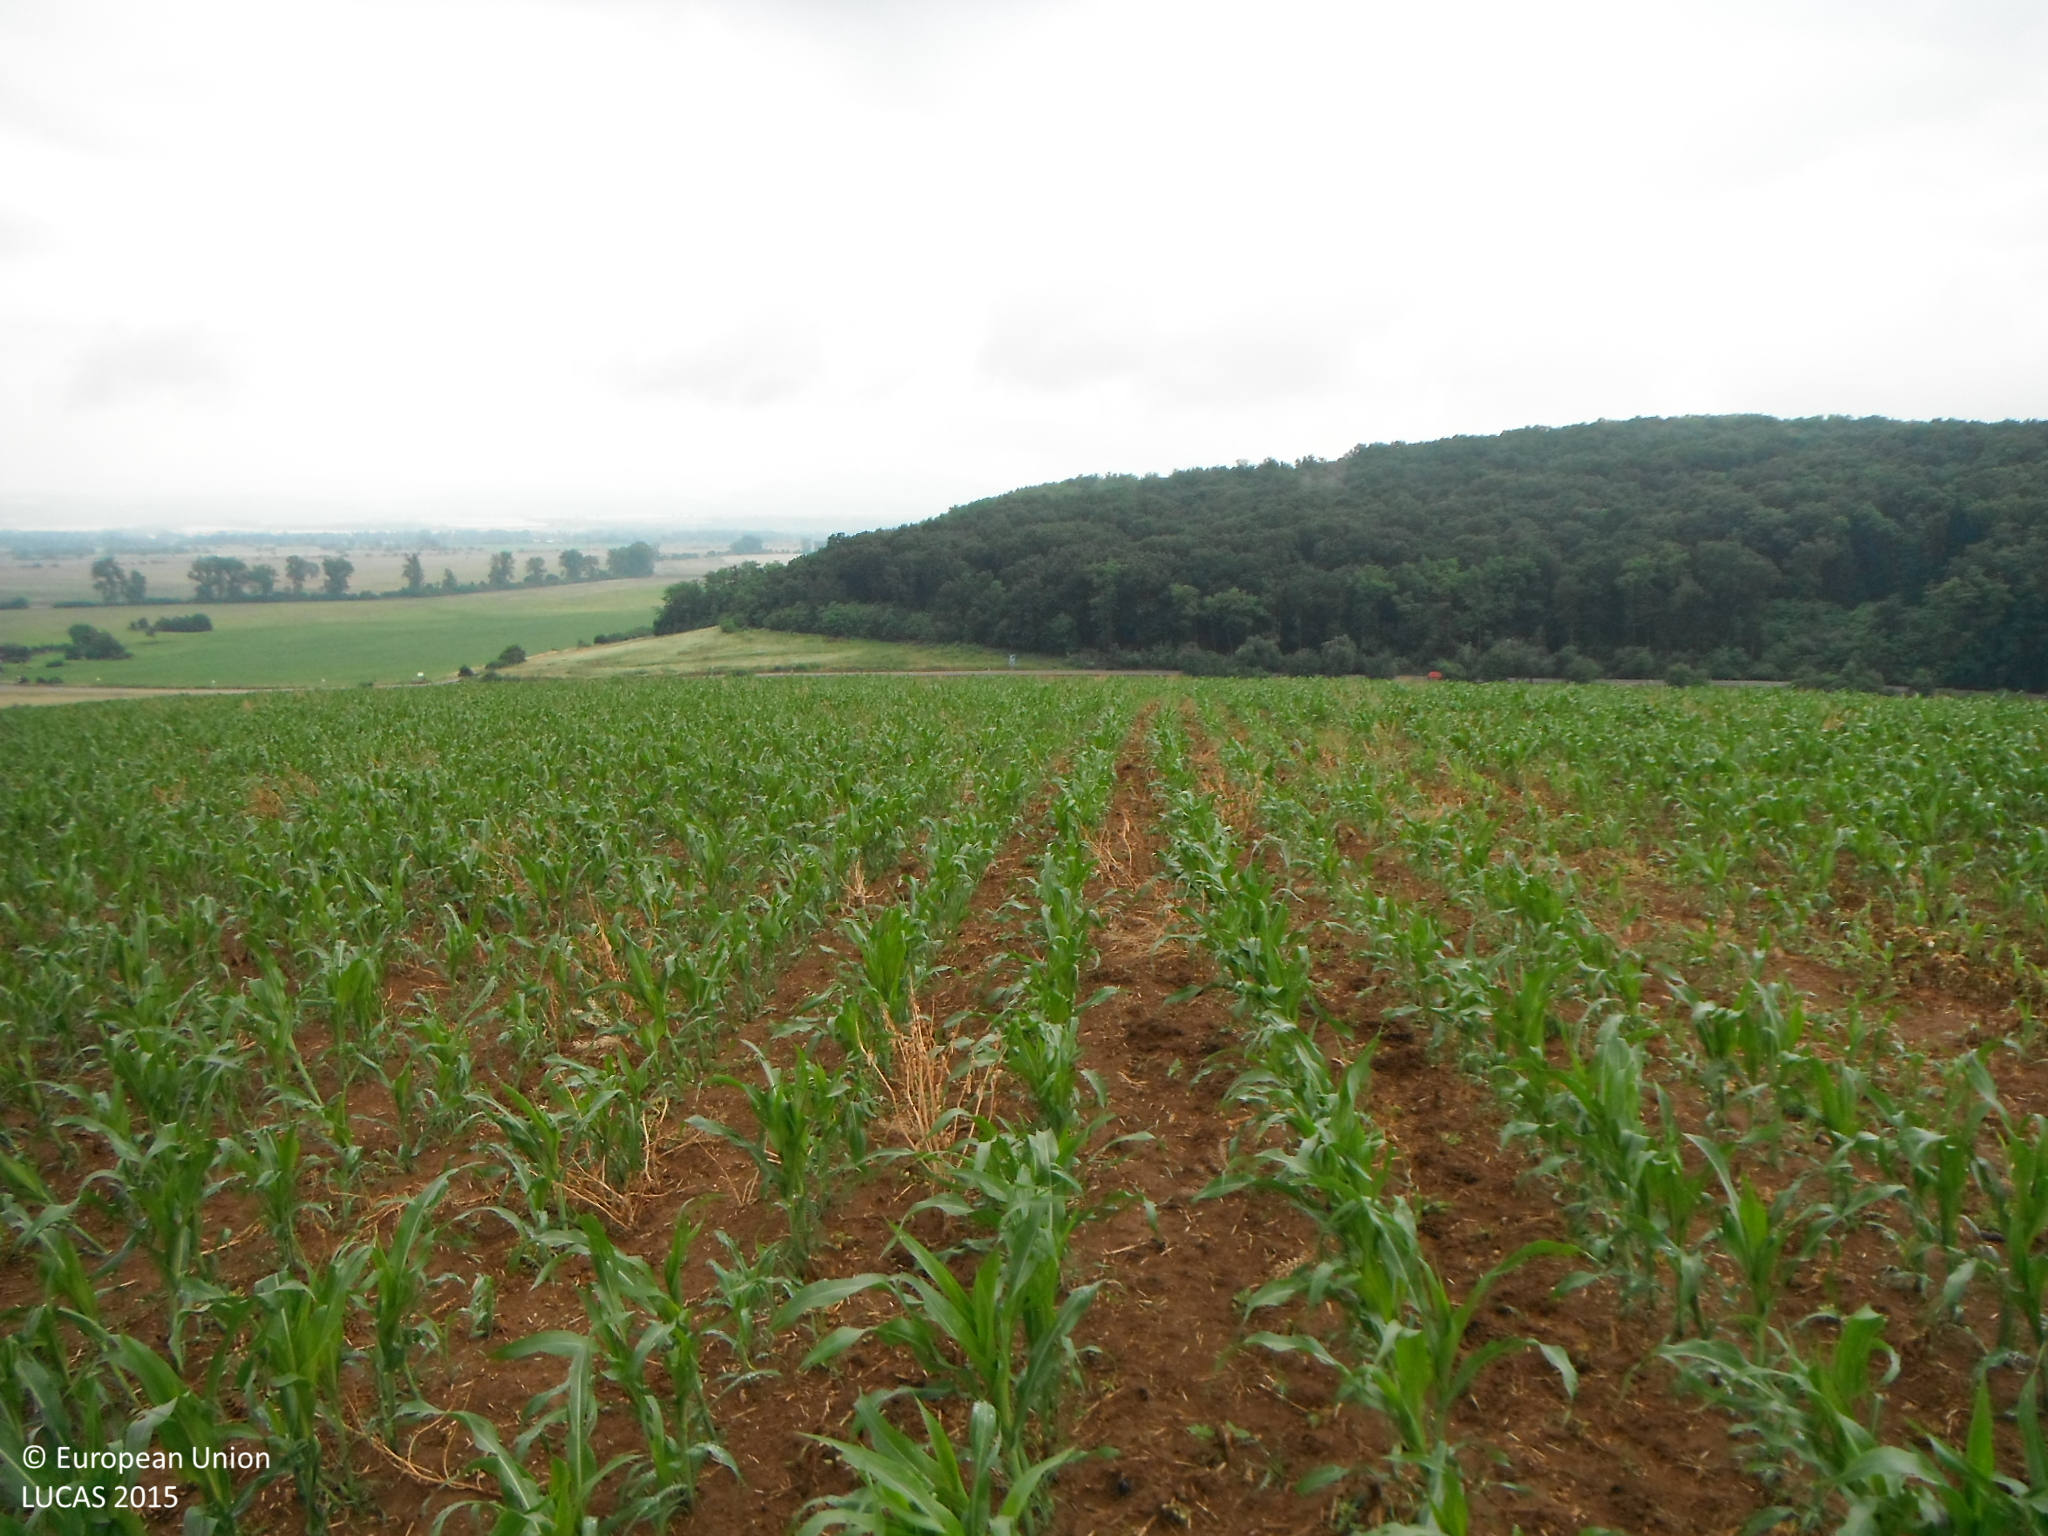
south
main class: Cropland
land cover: Maize
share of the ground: 50 - 75 %
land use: Agriculture (excluding fallow land and kitchen gardens)
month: June
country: SK
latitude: 48.1188
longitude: 18.8711
